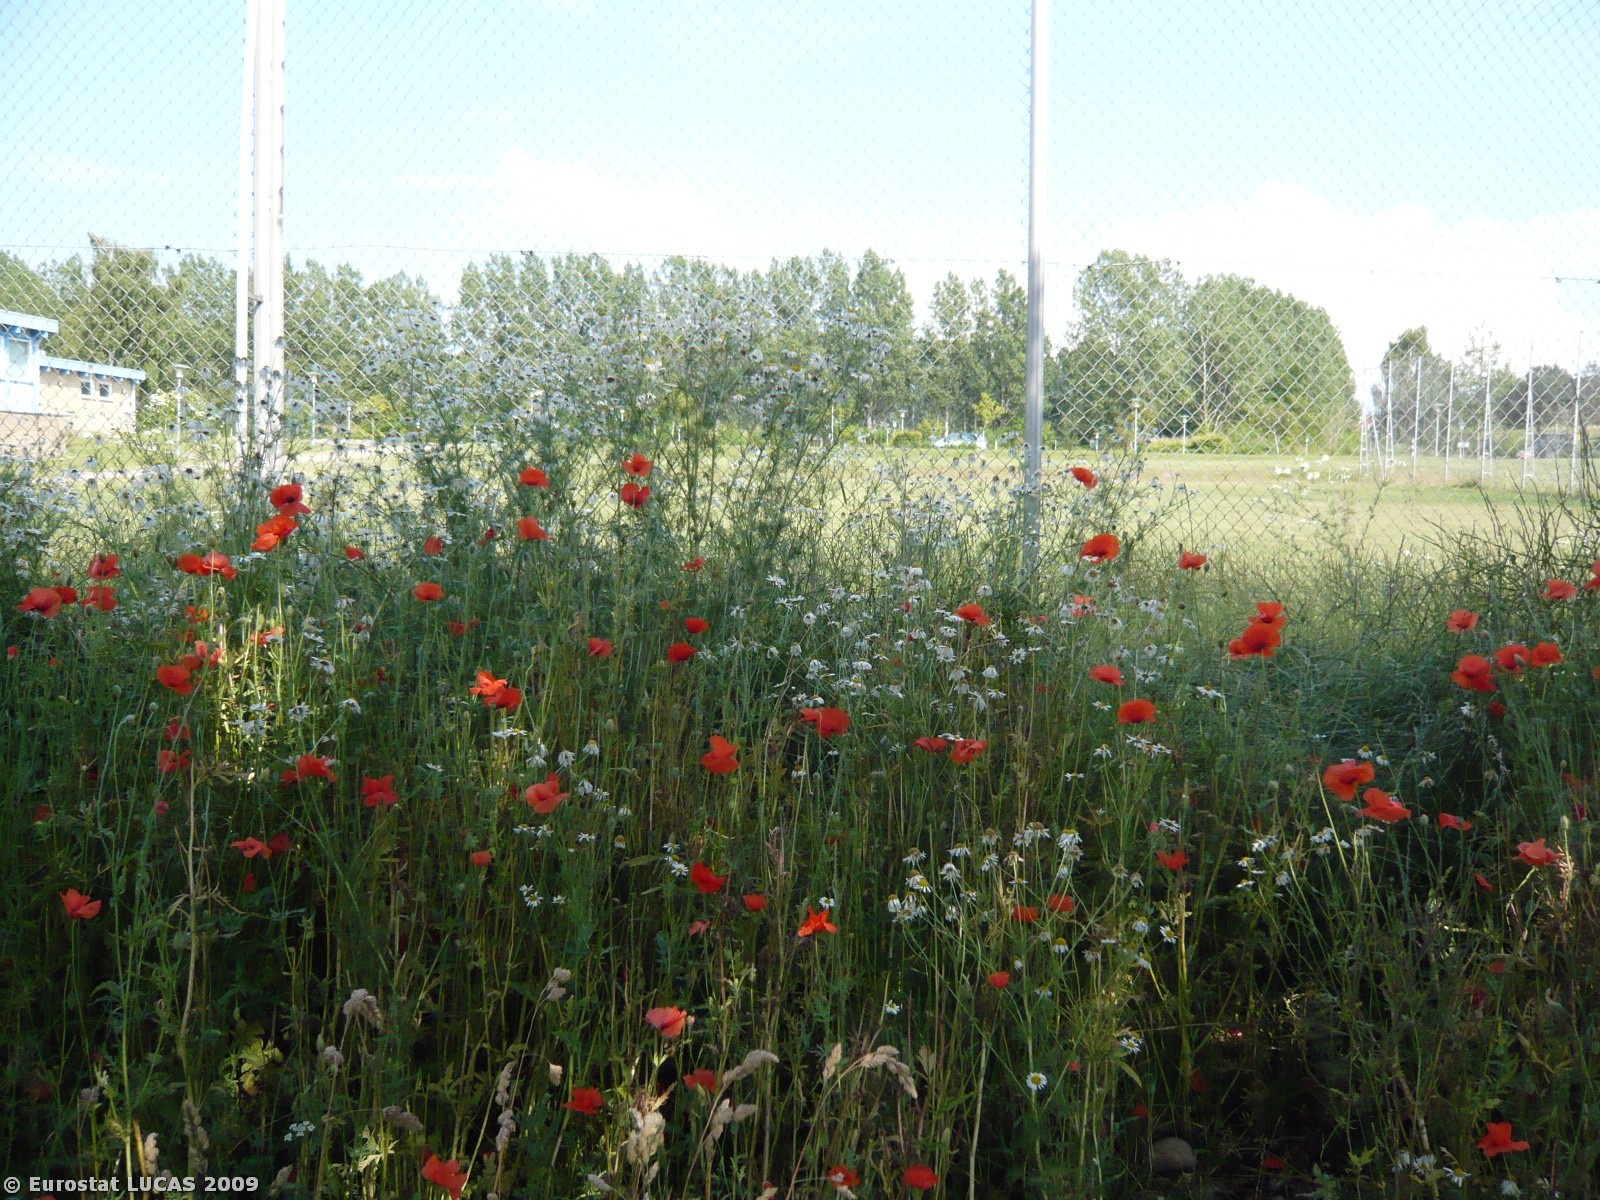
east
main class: Woodland
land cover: Broadleaved woodland
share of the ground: > 75 %
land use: Sport
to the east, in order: Broadleaved woodland; Grass margins; Artificial constructions; Spontaneously vegetated surfaces; Fences; Grassland without tree/shrub cover; Artificial constructions in urban areas; Broadleaved woodland; Grassland without tree/shrub cover
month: July
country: DK
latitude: 55.9079
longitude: 11.6140
